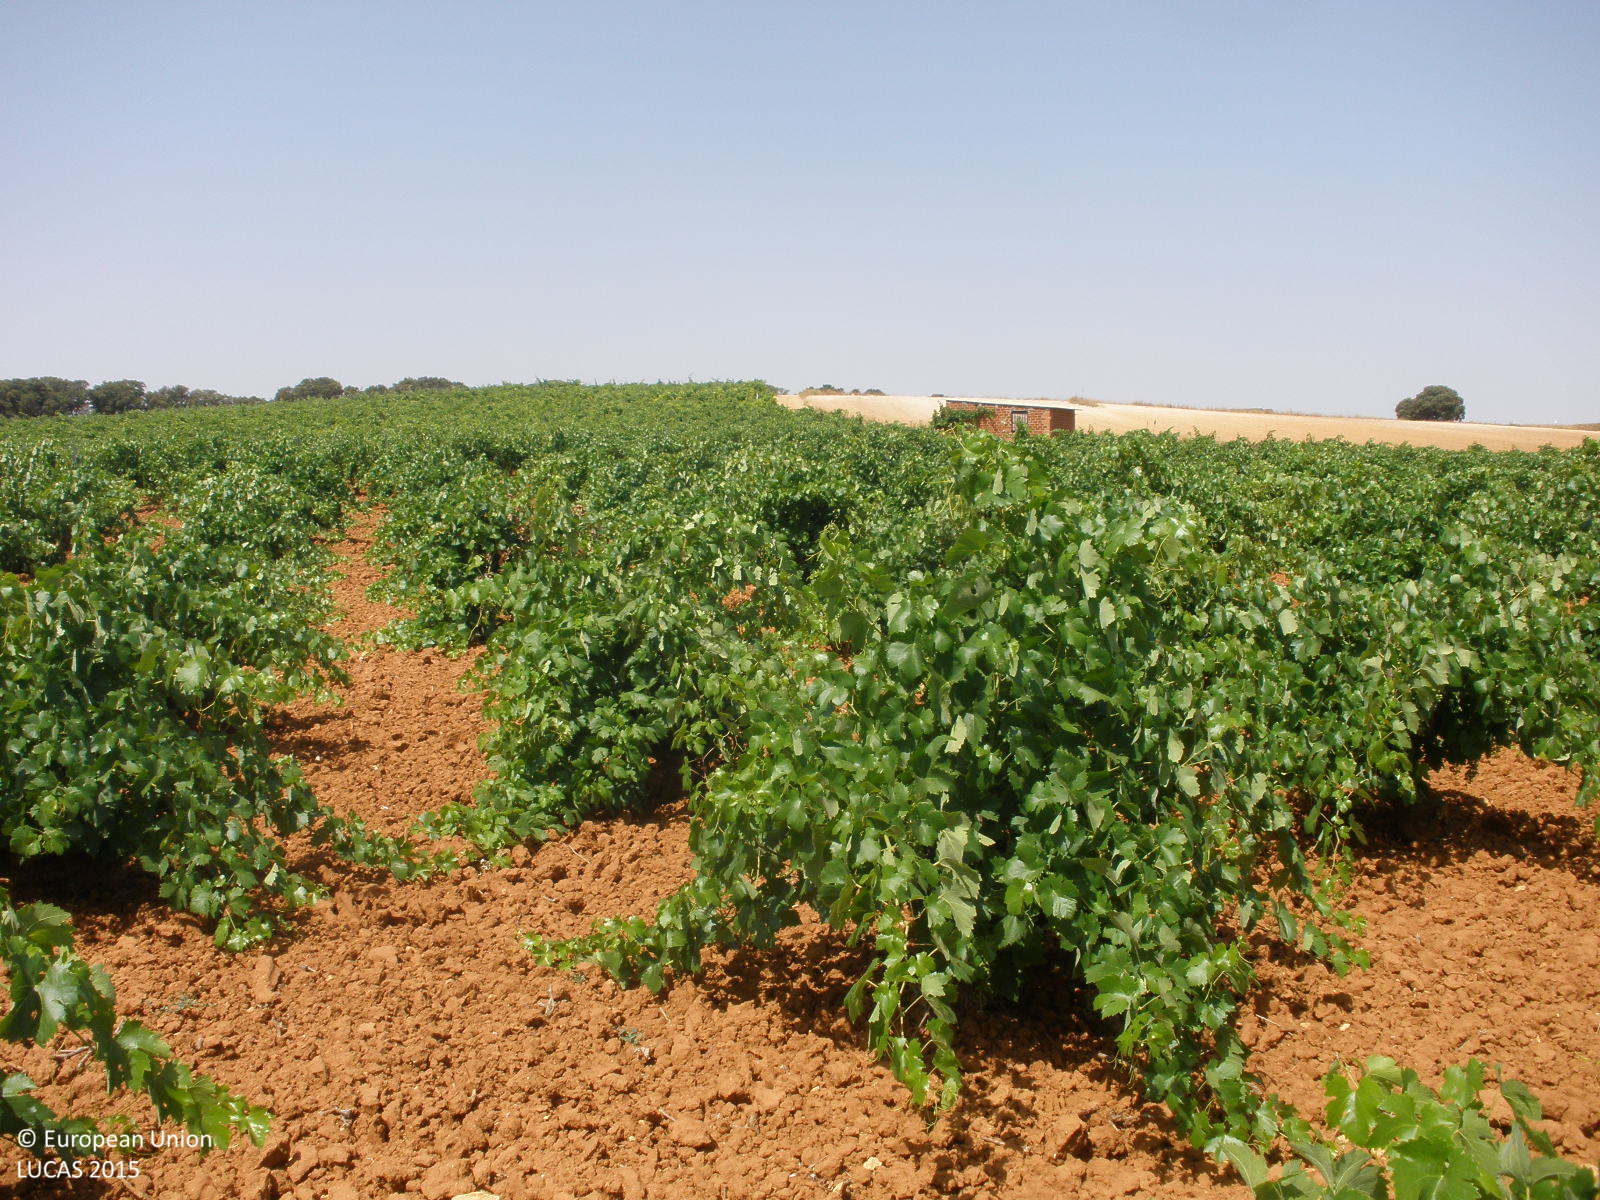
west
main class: Cropland
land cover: Vineyards
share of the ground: 50 - 75 %
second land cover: Other bare soil
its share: > 75 %
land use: Agriculture (excluding fallow land and kitchen gardens)
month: July
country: ES
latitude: 39.9106
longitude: -3.1375
